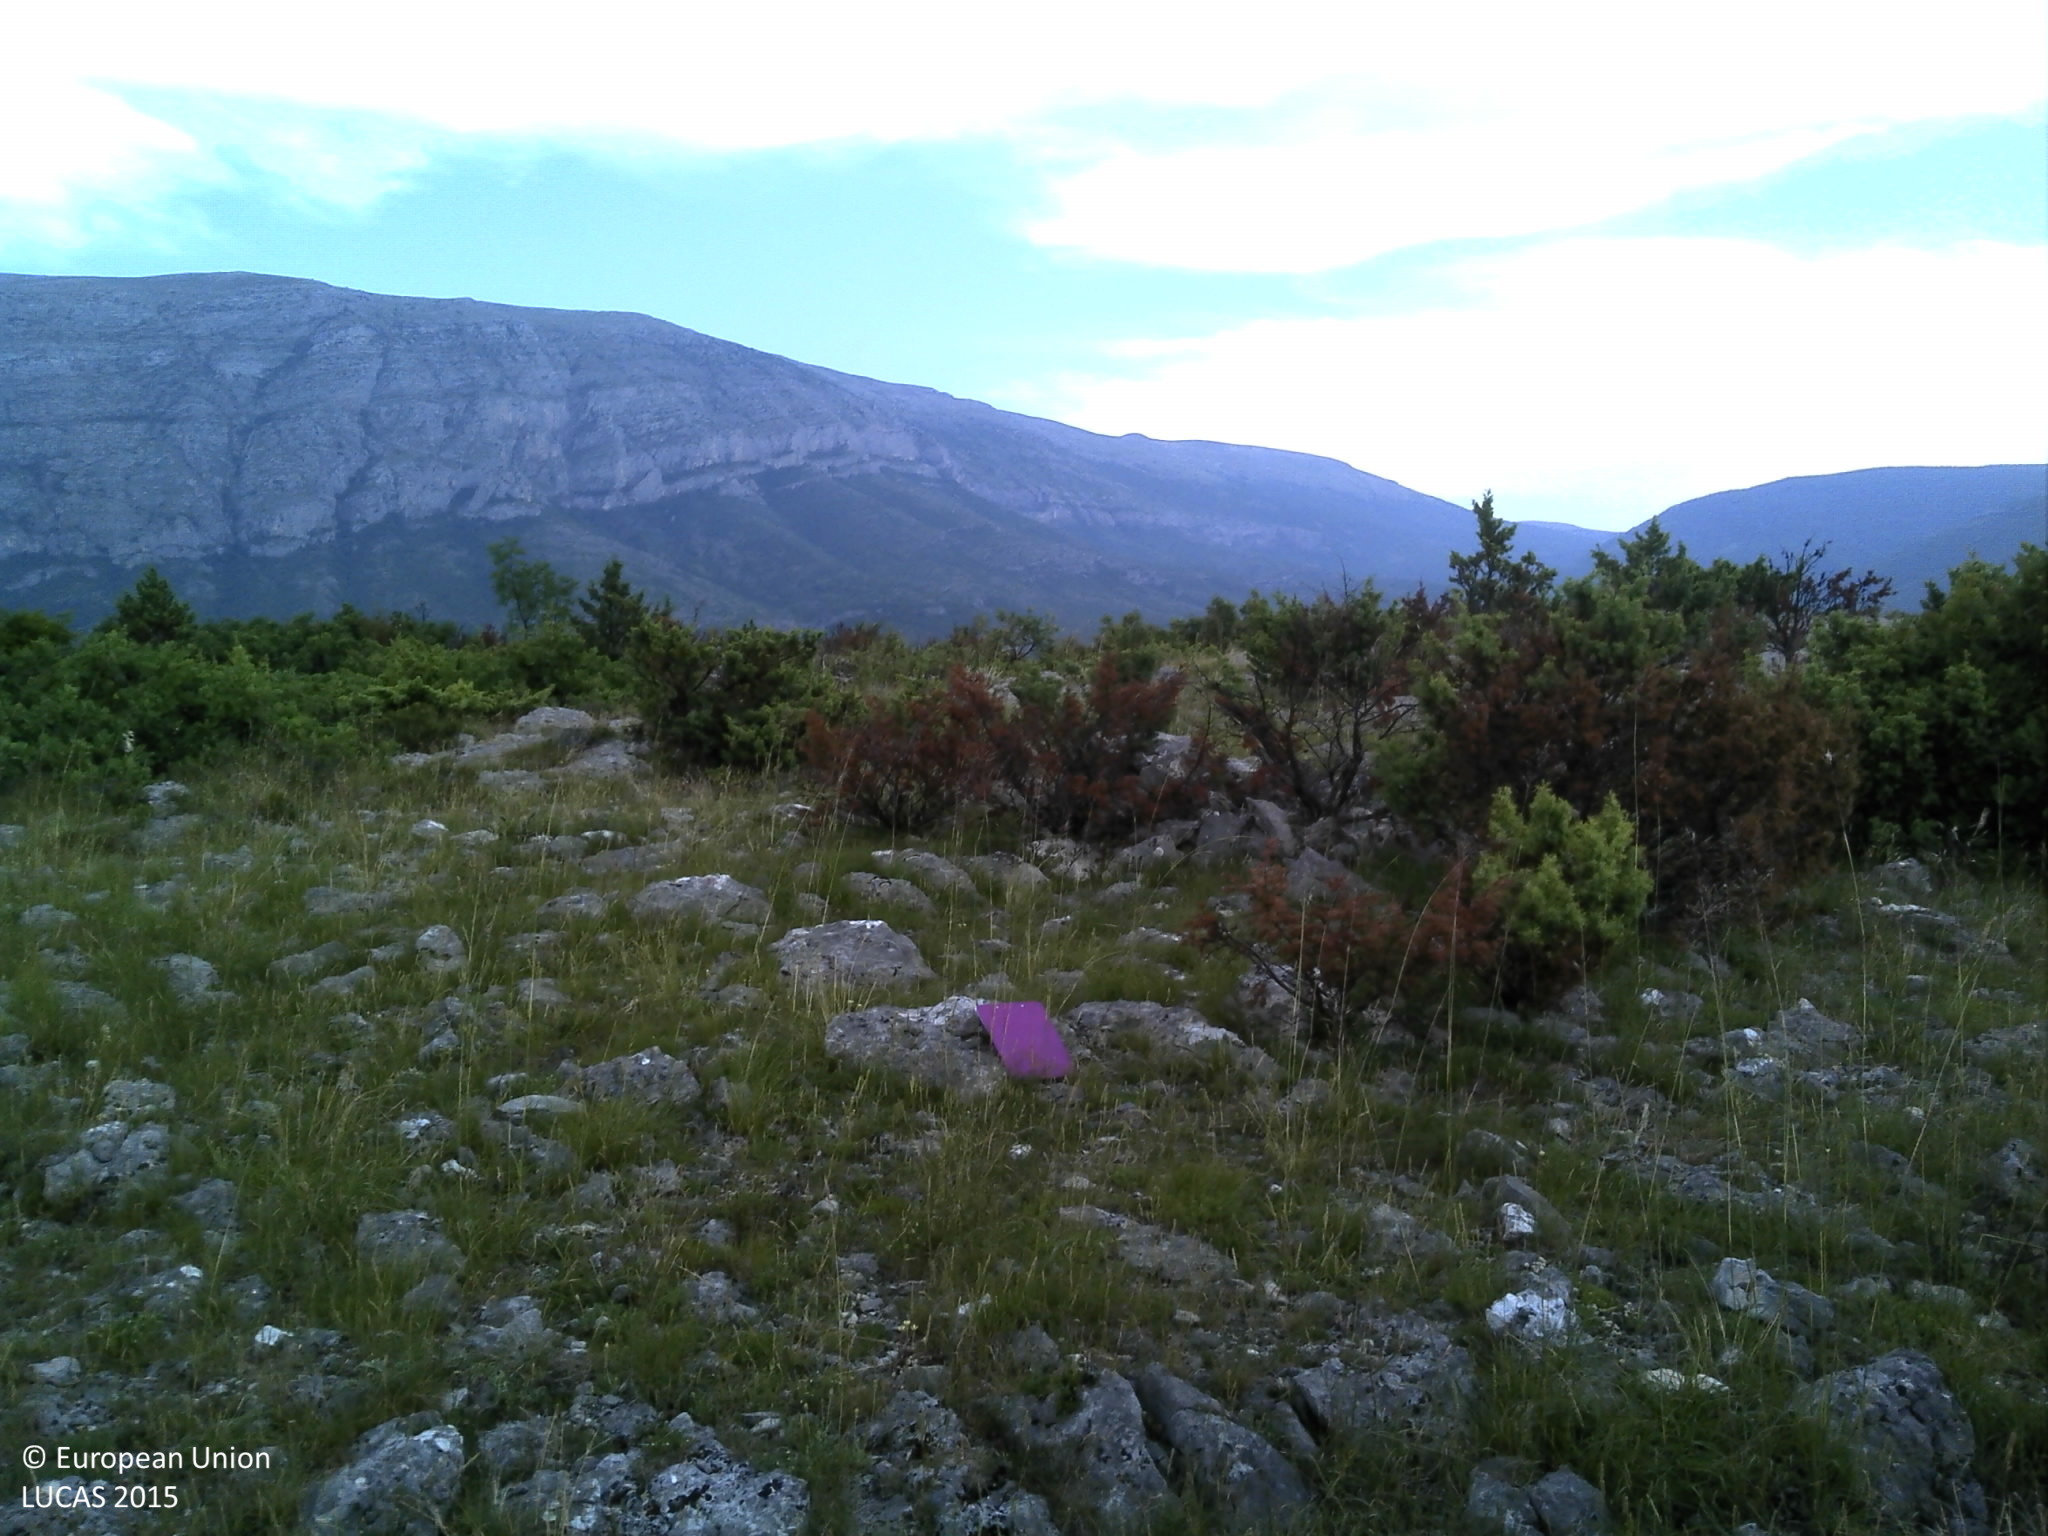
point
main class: Shrubland
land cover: Shrubland with sparse tree cover
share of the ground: 10 - 25 %
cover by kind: herbaceous plants 45 %, shrubs 20 %, unconsolidated bare surface 20 %, consolidated bare surface 10 %, broadleaved forest trees 5 %
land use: Agriculture (excluding fallow land and kitchen gardens)
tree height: < 5 m
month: June
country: HR
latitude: 43.9323
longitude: 16.4575
